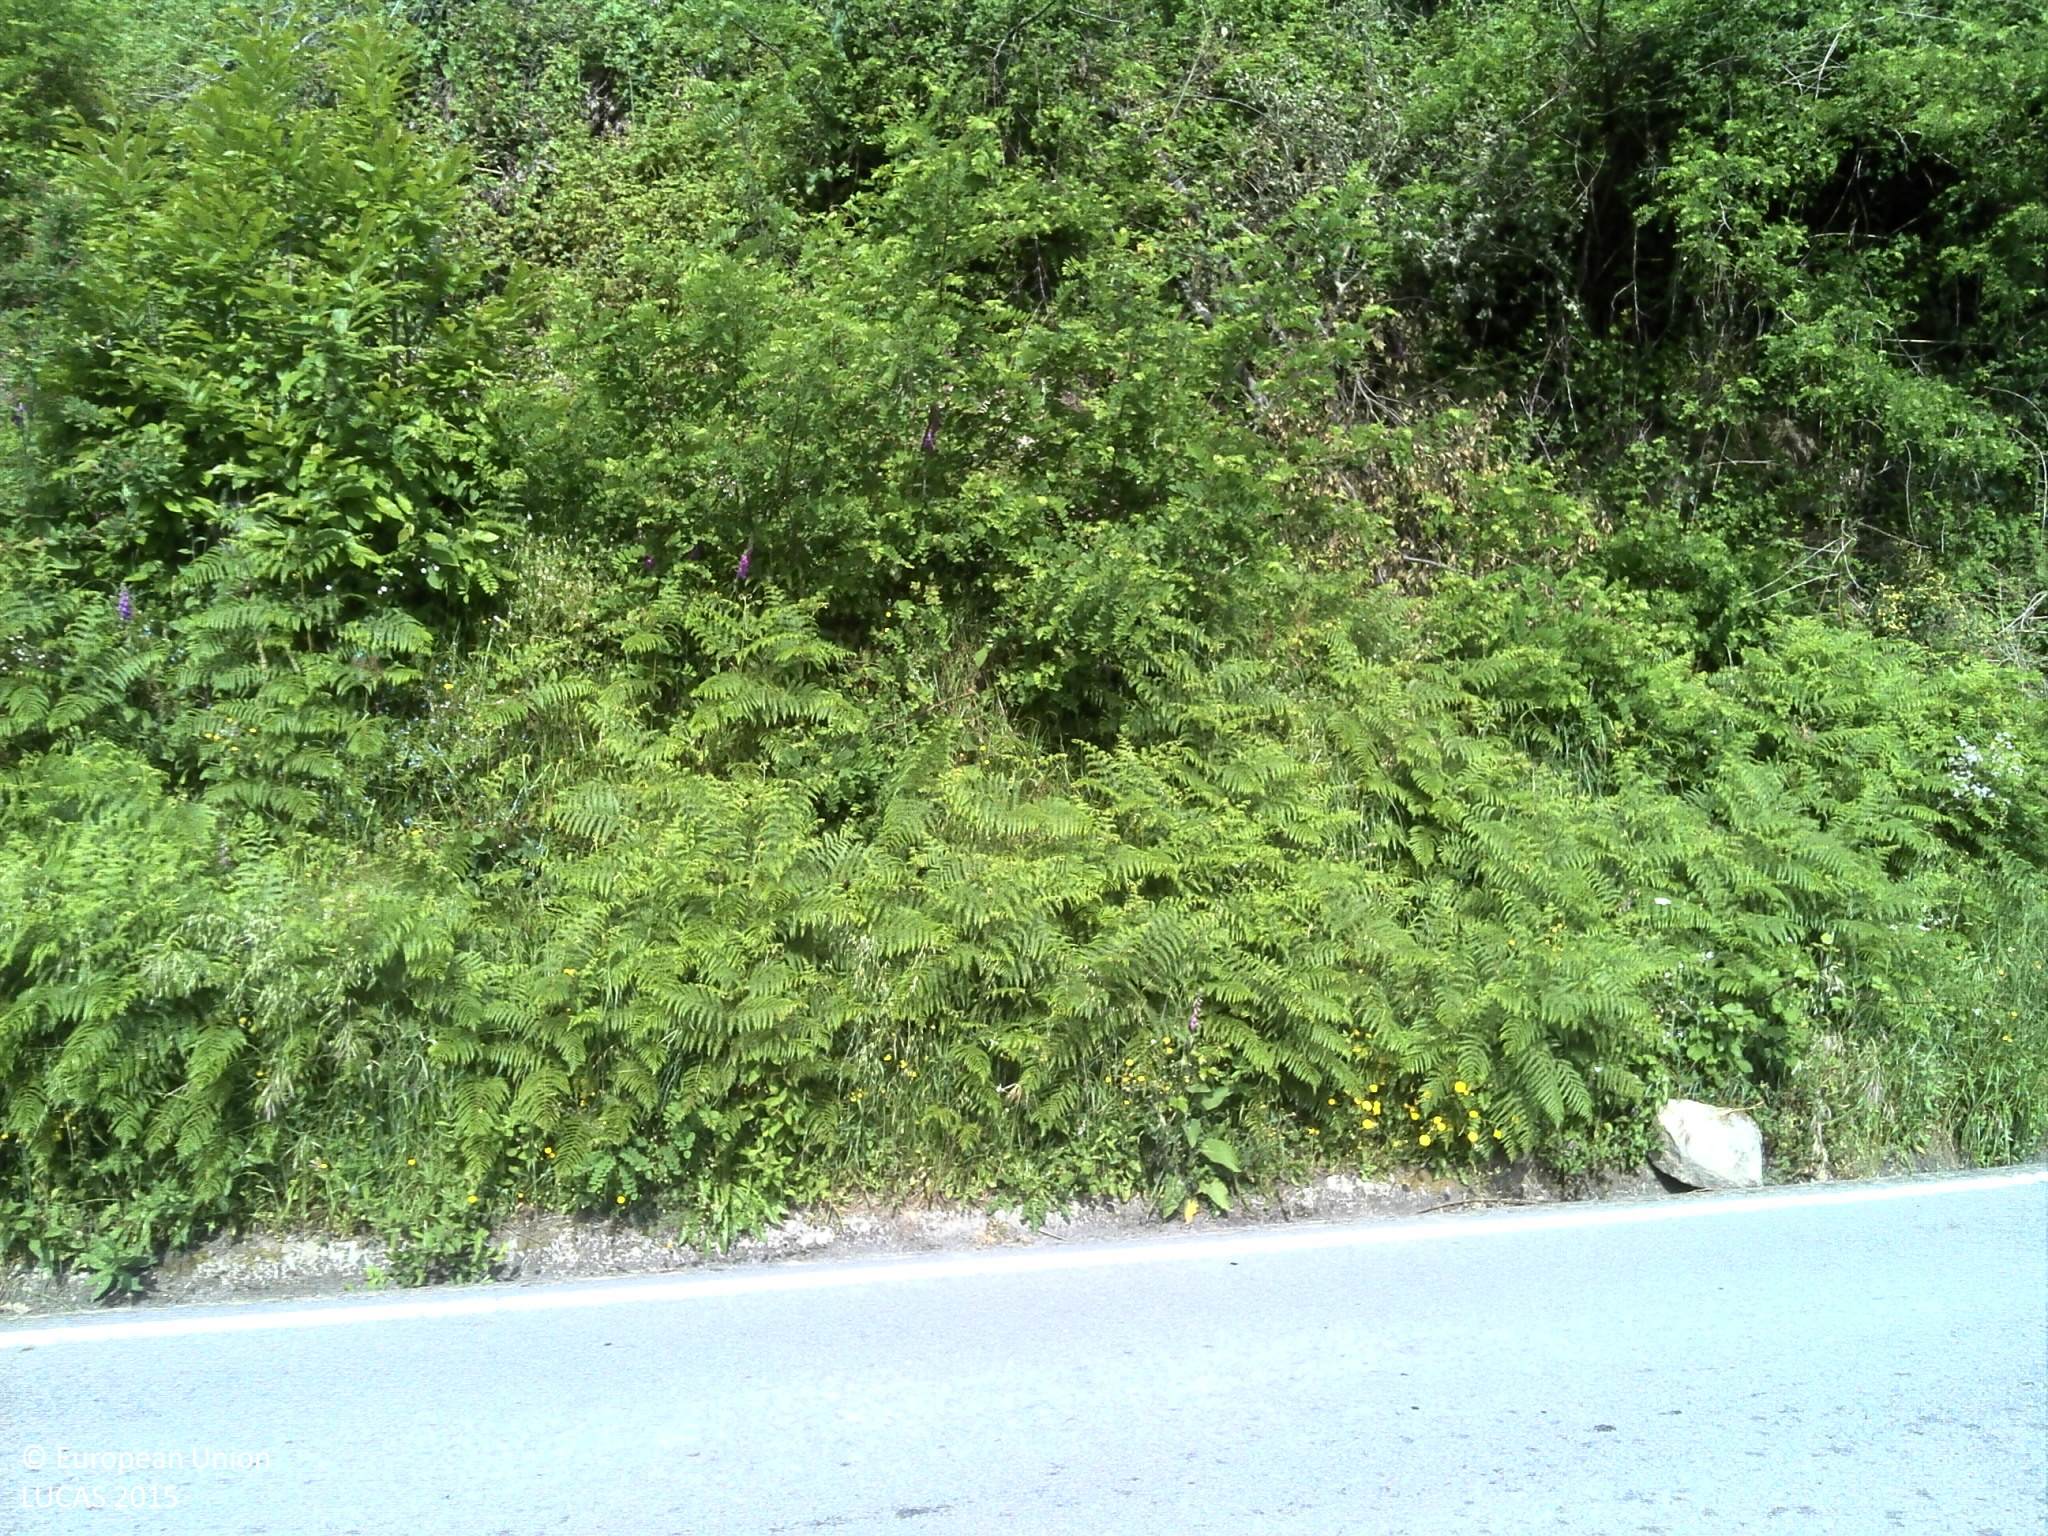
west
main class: Woodland
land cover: Broadleaved woodland
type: thermophilous deciduous forest
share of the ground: > 75 %
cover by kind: broadleaved forest trees 85 %, shrubs 5 %, herbaceous plants 5 %, unconsolidated bare surface 5 %
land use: Forestry
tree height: > 5 m
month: May
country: PT
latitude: 41.0770
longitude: -8.1217
